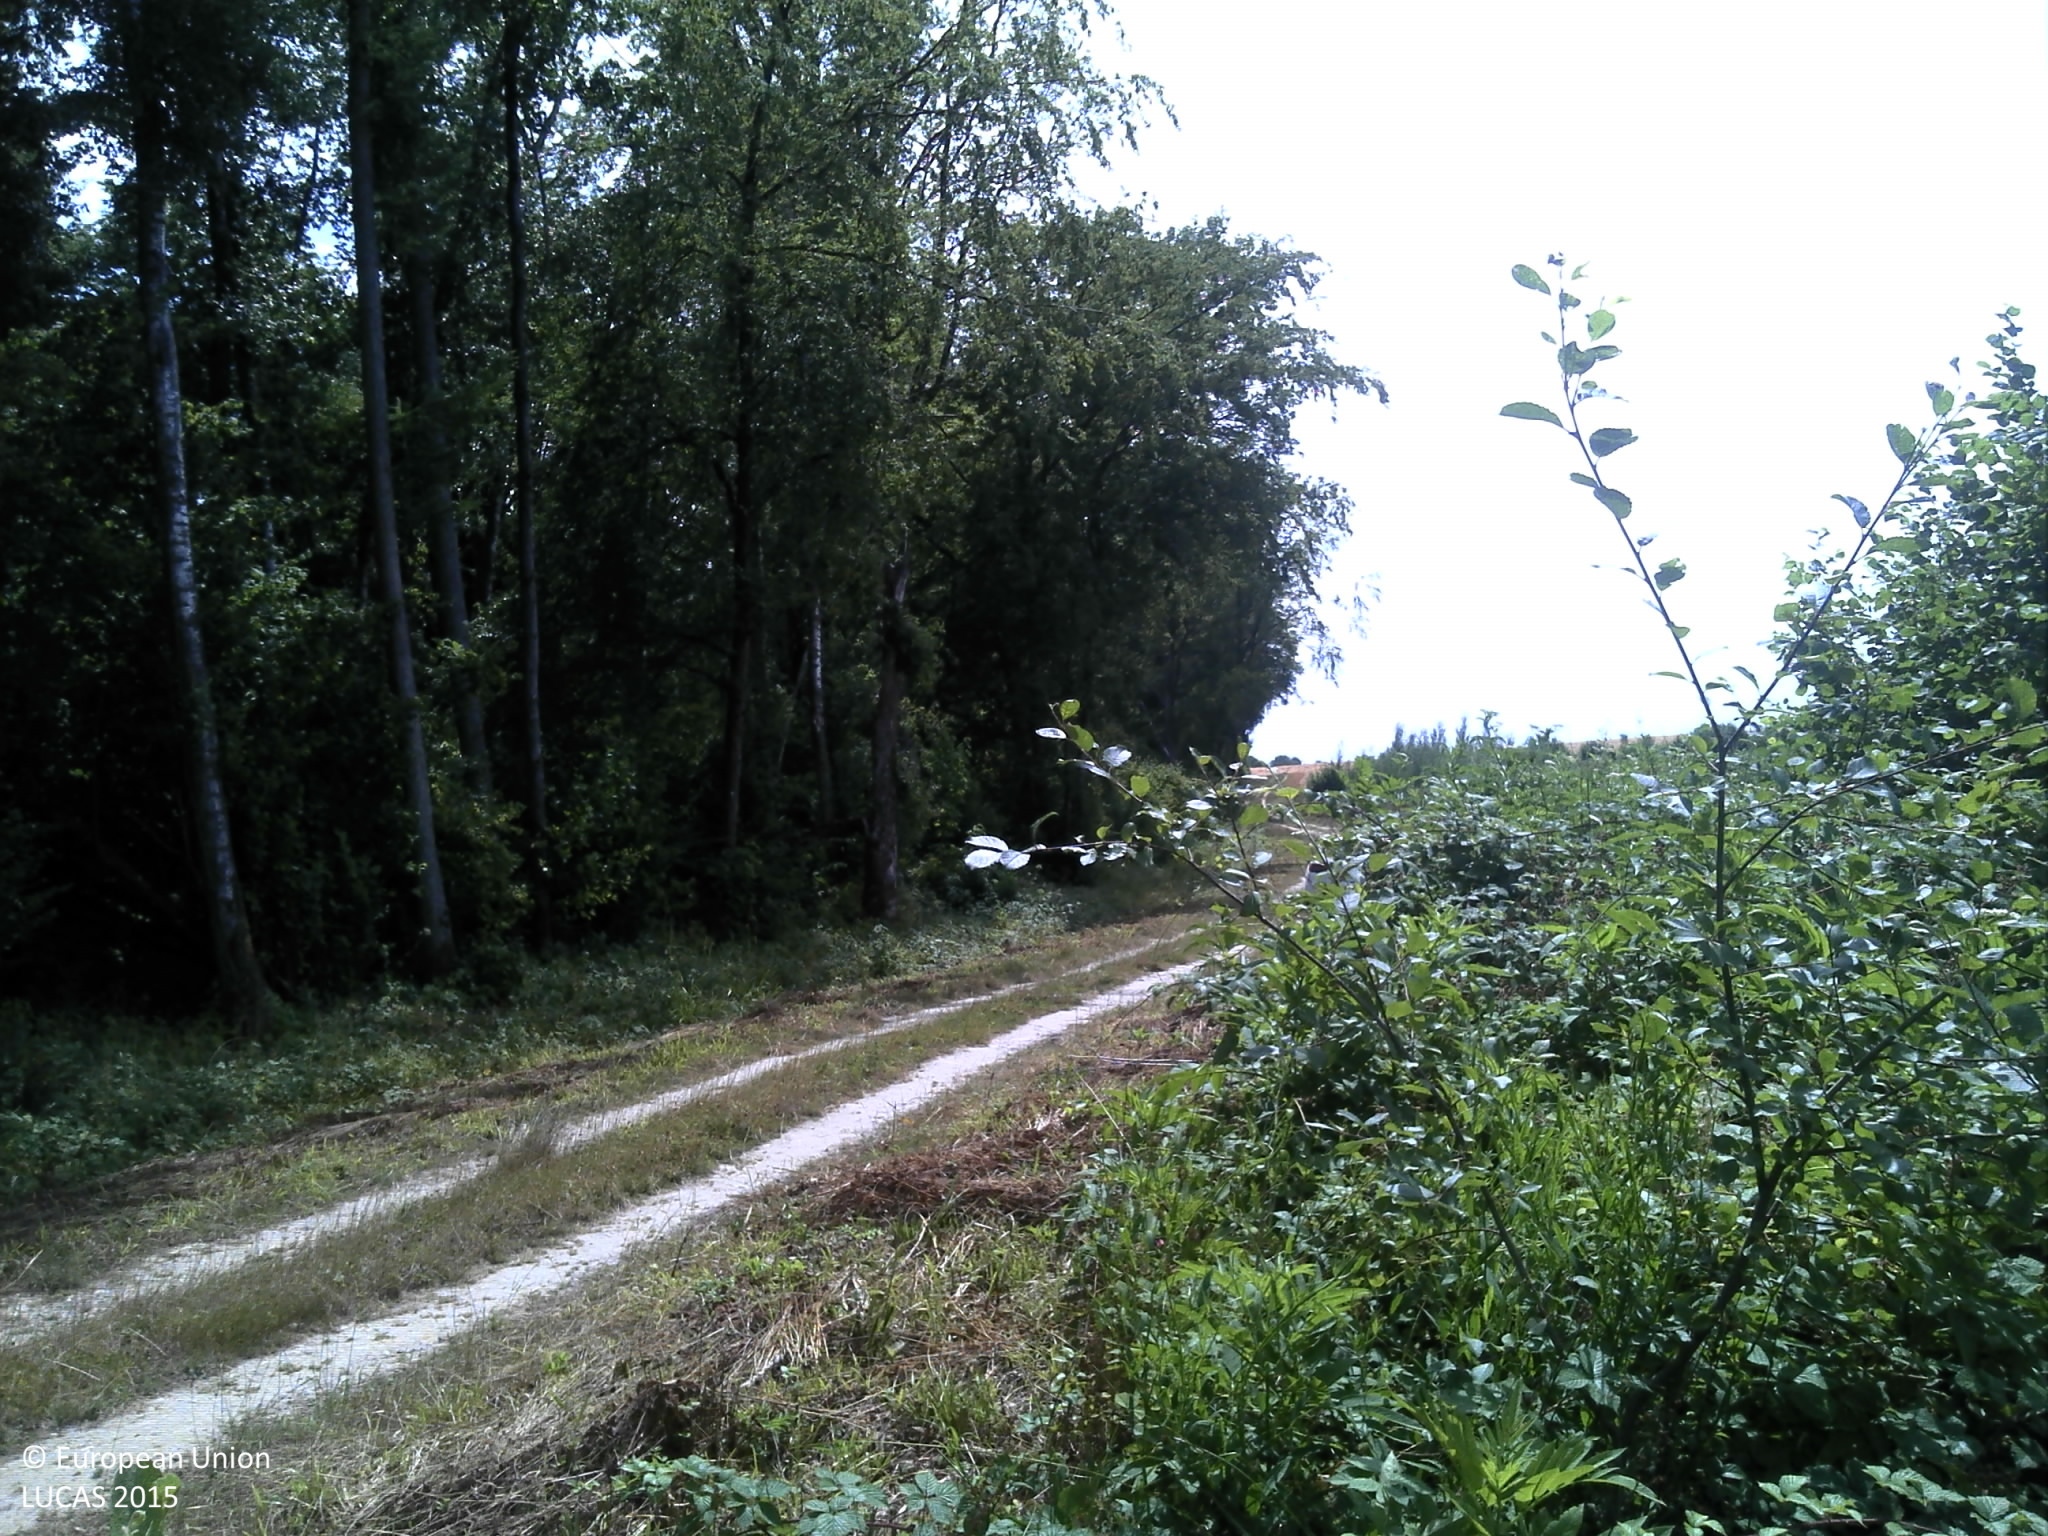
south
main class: Woodland
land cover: Broadleaved woodland
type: non-riverine alder, birch or aspen forest
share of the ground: > 75 %
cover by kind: broadleaved forest trees 50 %, herbaceous plants 50 %
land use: Forestry
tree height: < 5 m
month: July
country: FR
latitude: 49.6245
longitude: 4.2505
